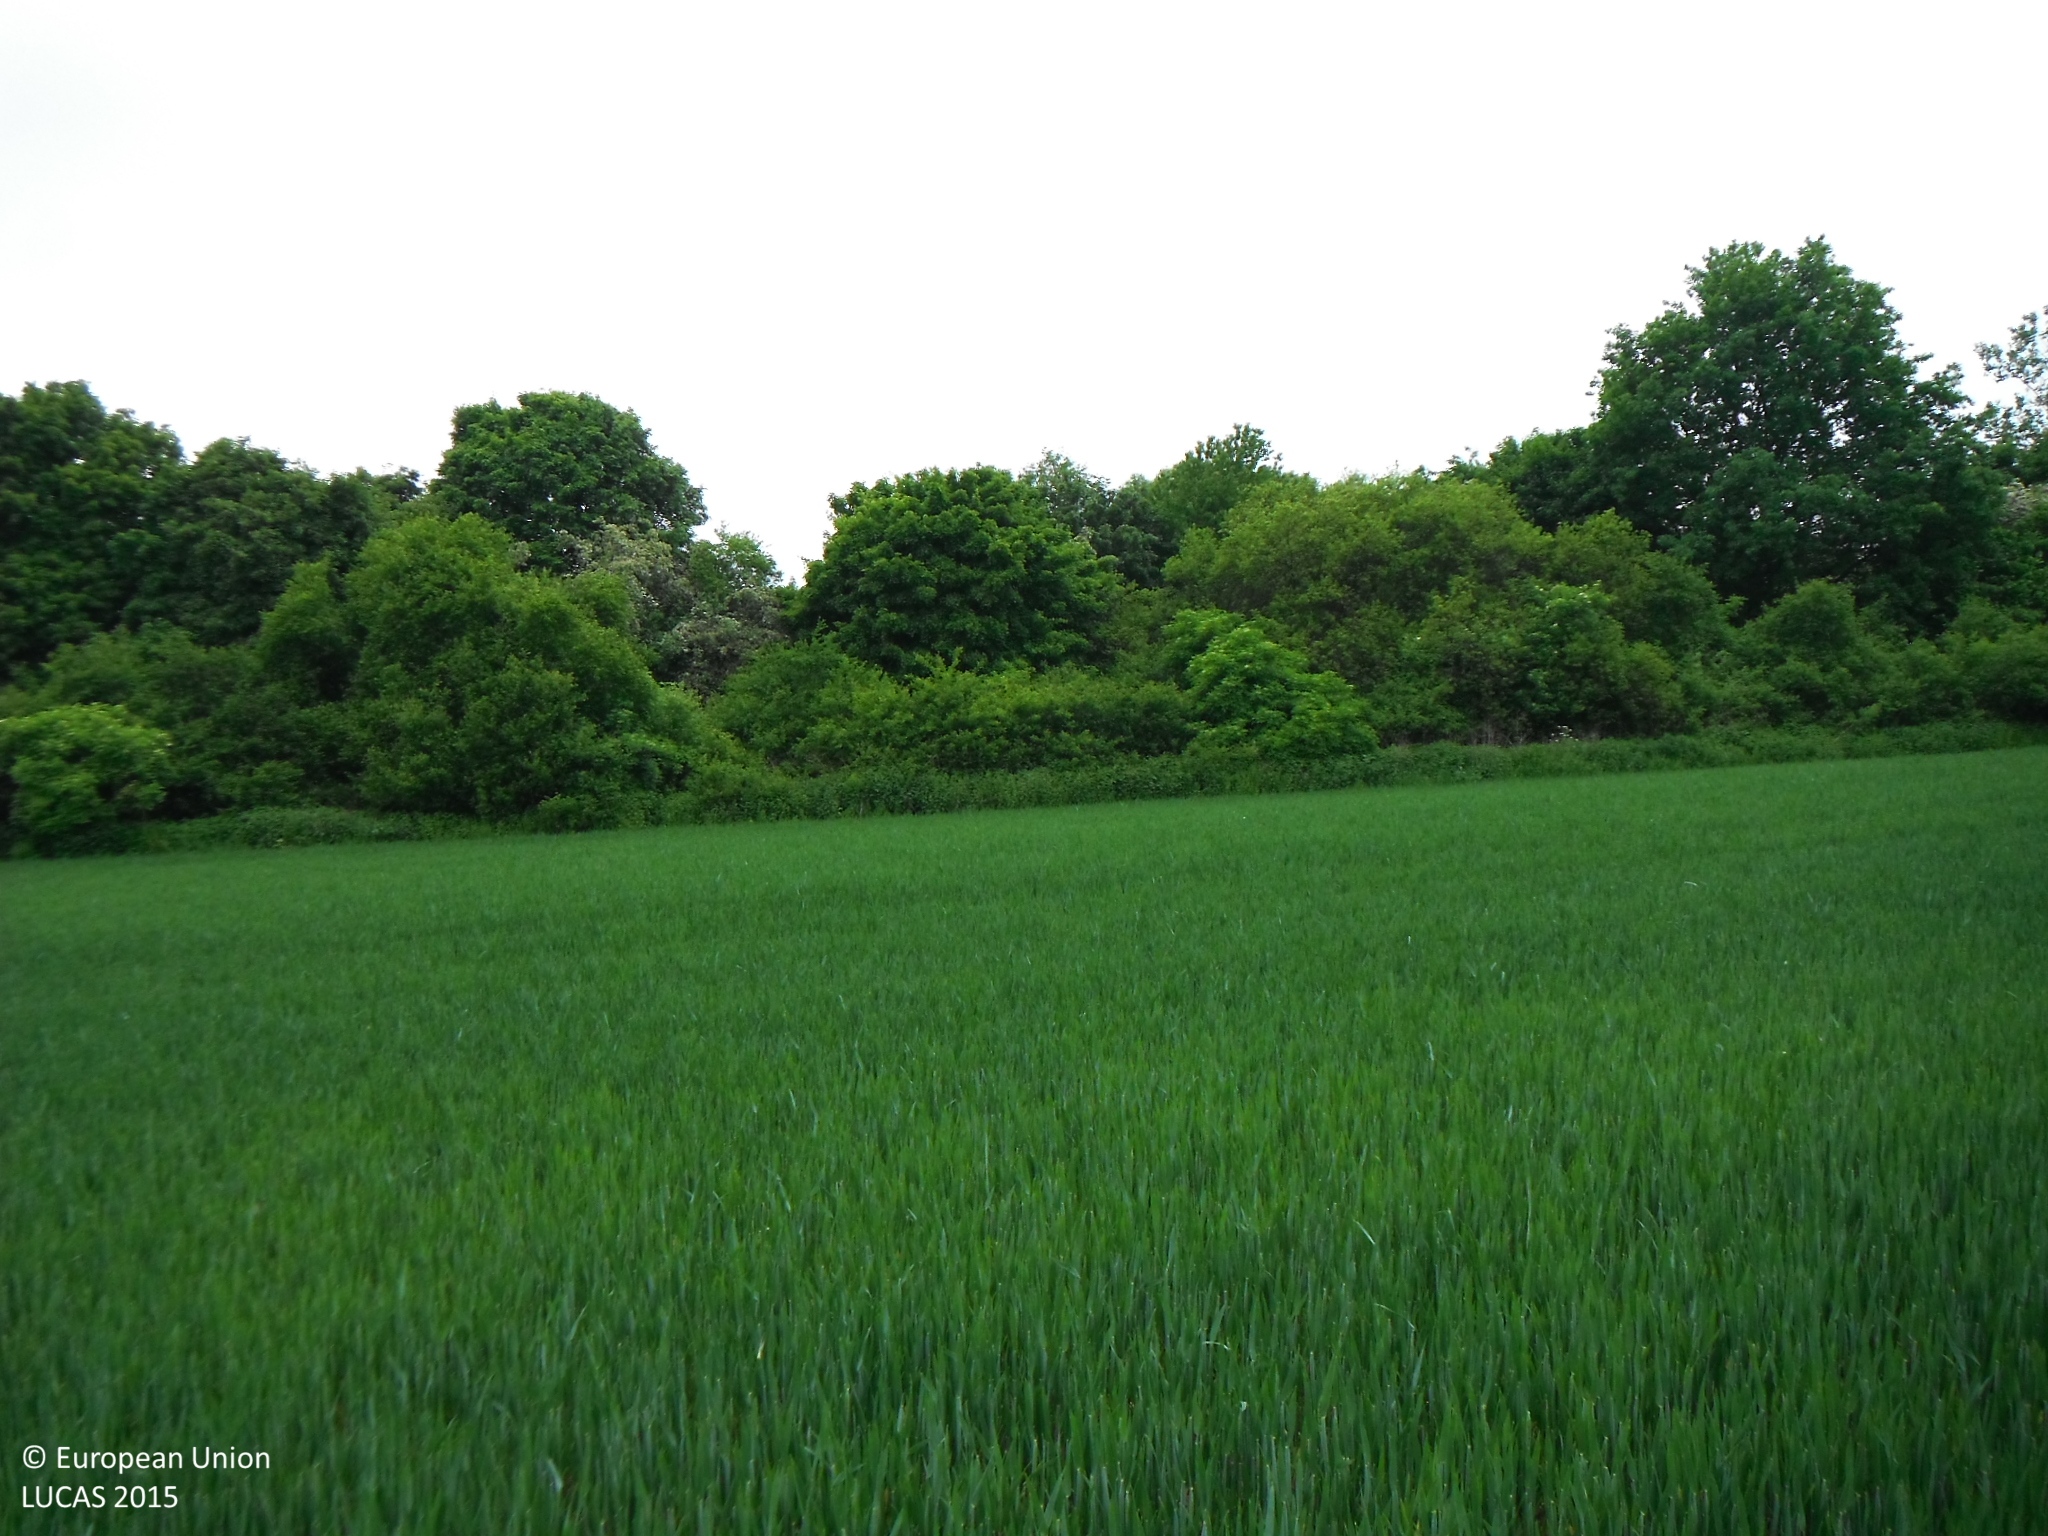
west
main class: Cropland
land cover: Common wheat
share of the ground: > 75 %
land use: Agriculture (excluding fallow land and kitchen gardens)
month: May
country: SK
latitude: 49.0047
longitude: 21.1024
